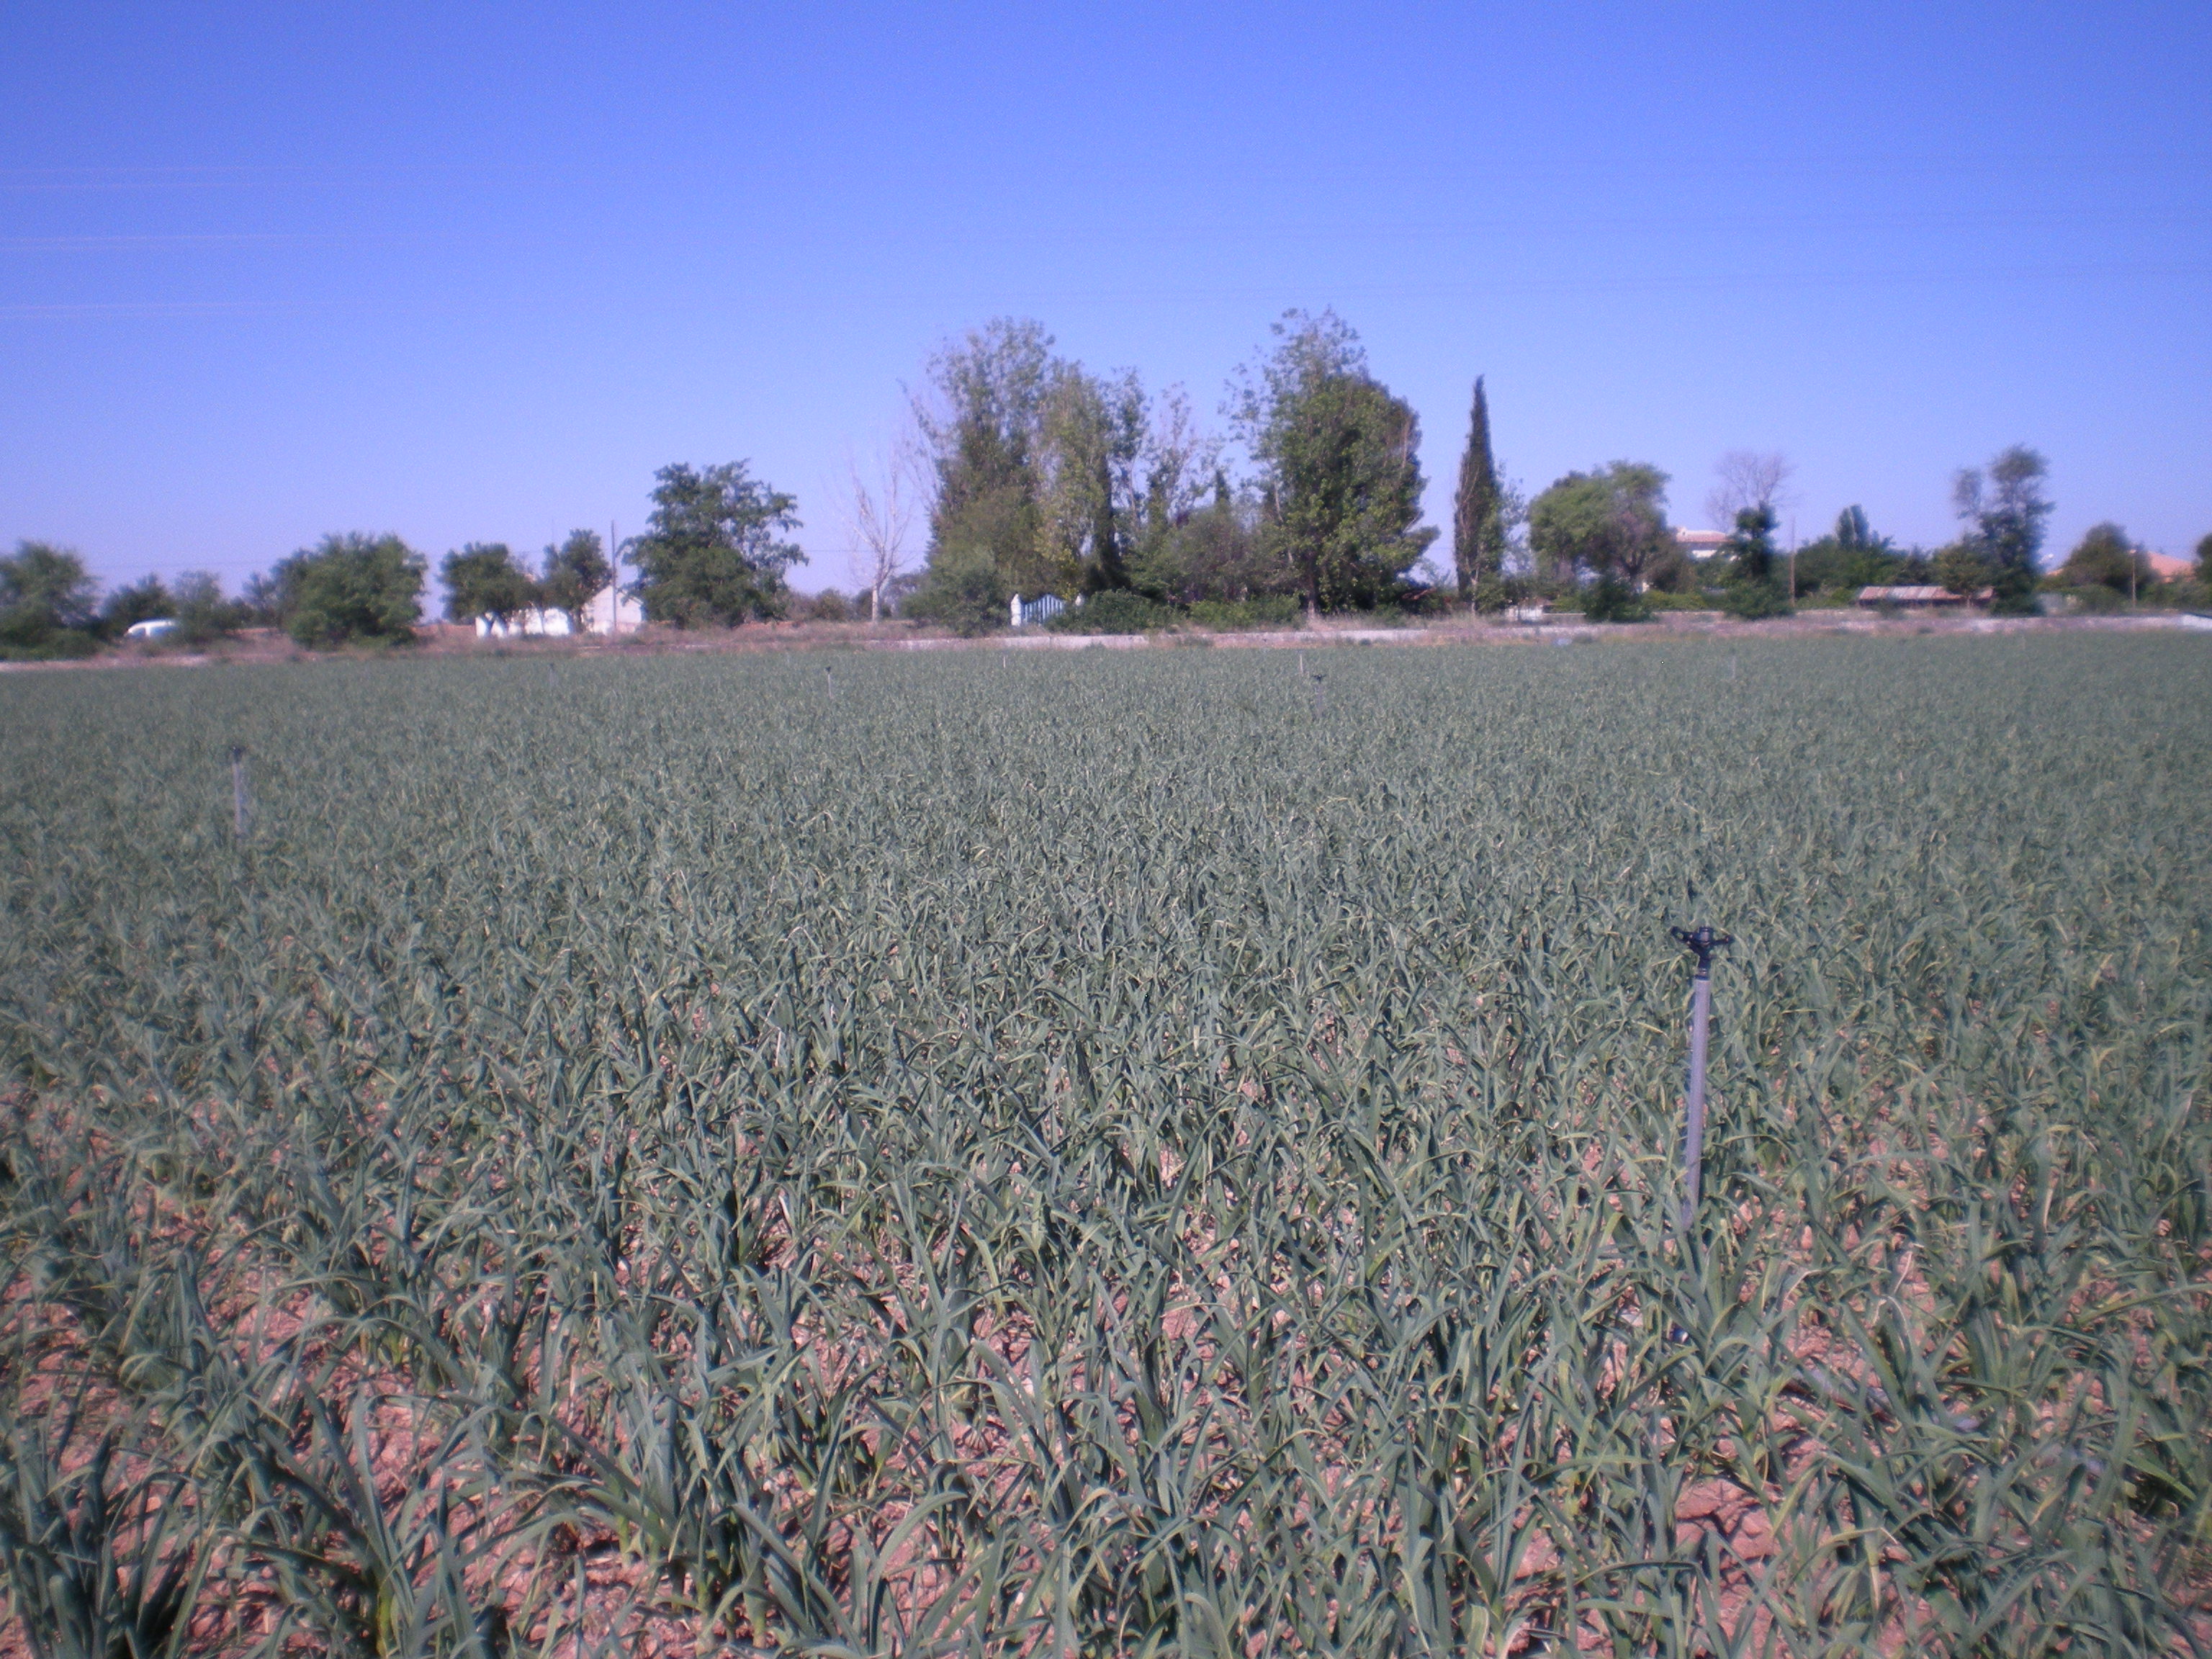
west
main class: Cropland
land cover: Other root crops
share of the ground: 50 - 75 %
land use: Agriculture (excluding fallow land and kitchen gardens)
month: May
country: ES
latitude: 39.0964
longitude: -3.0663
